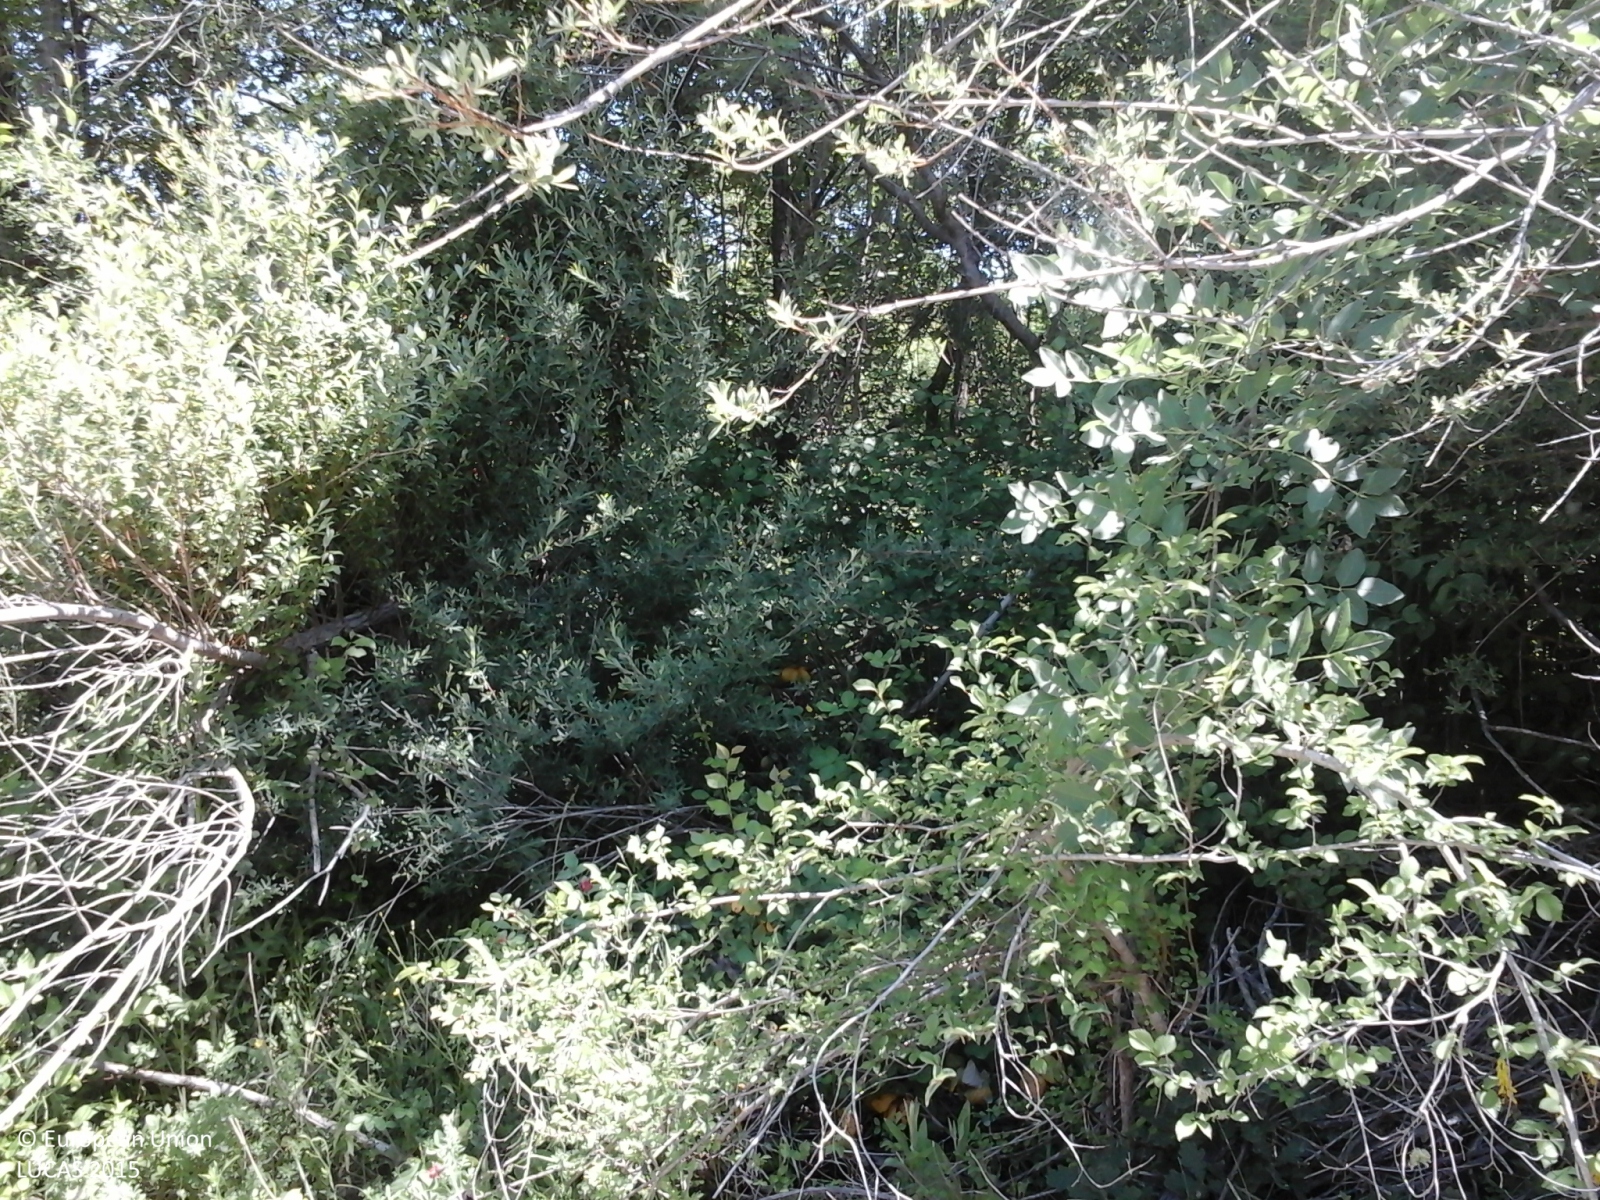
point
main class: Woodland
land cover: Broadleaved woodland
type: thermophilous deciduous forest
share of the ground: > 75 %
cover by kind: broadleaved forest trees 80 %, shrubs 10 %, herbaceous plants 10 %
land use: Forestry
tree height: > 5 m
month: June
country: IT
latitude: 41.9757
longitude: 14.4870
